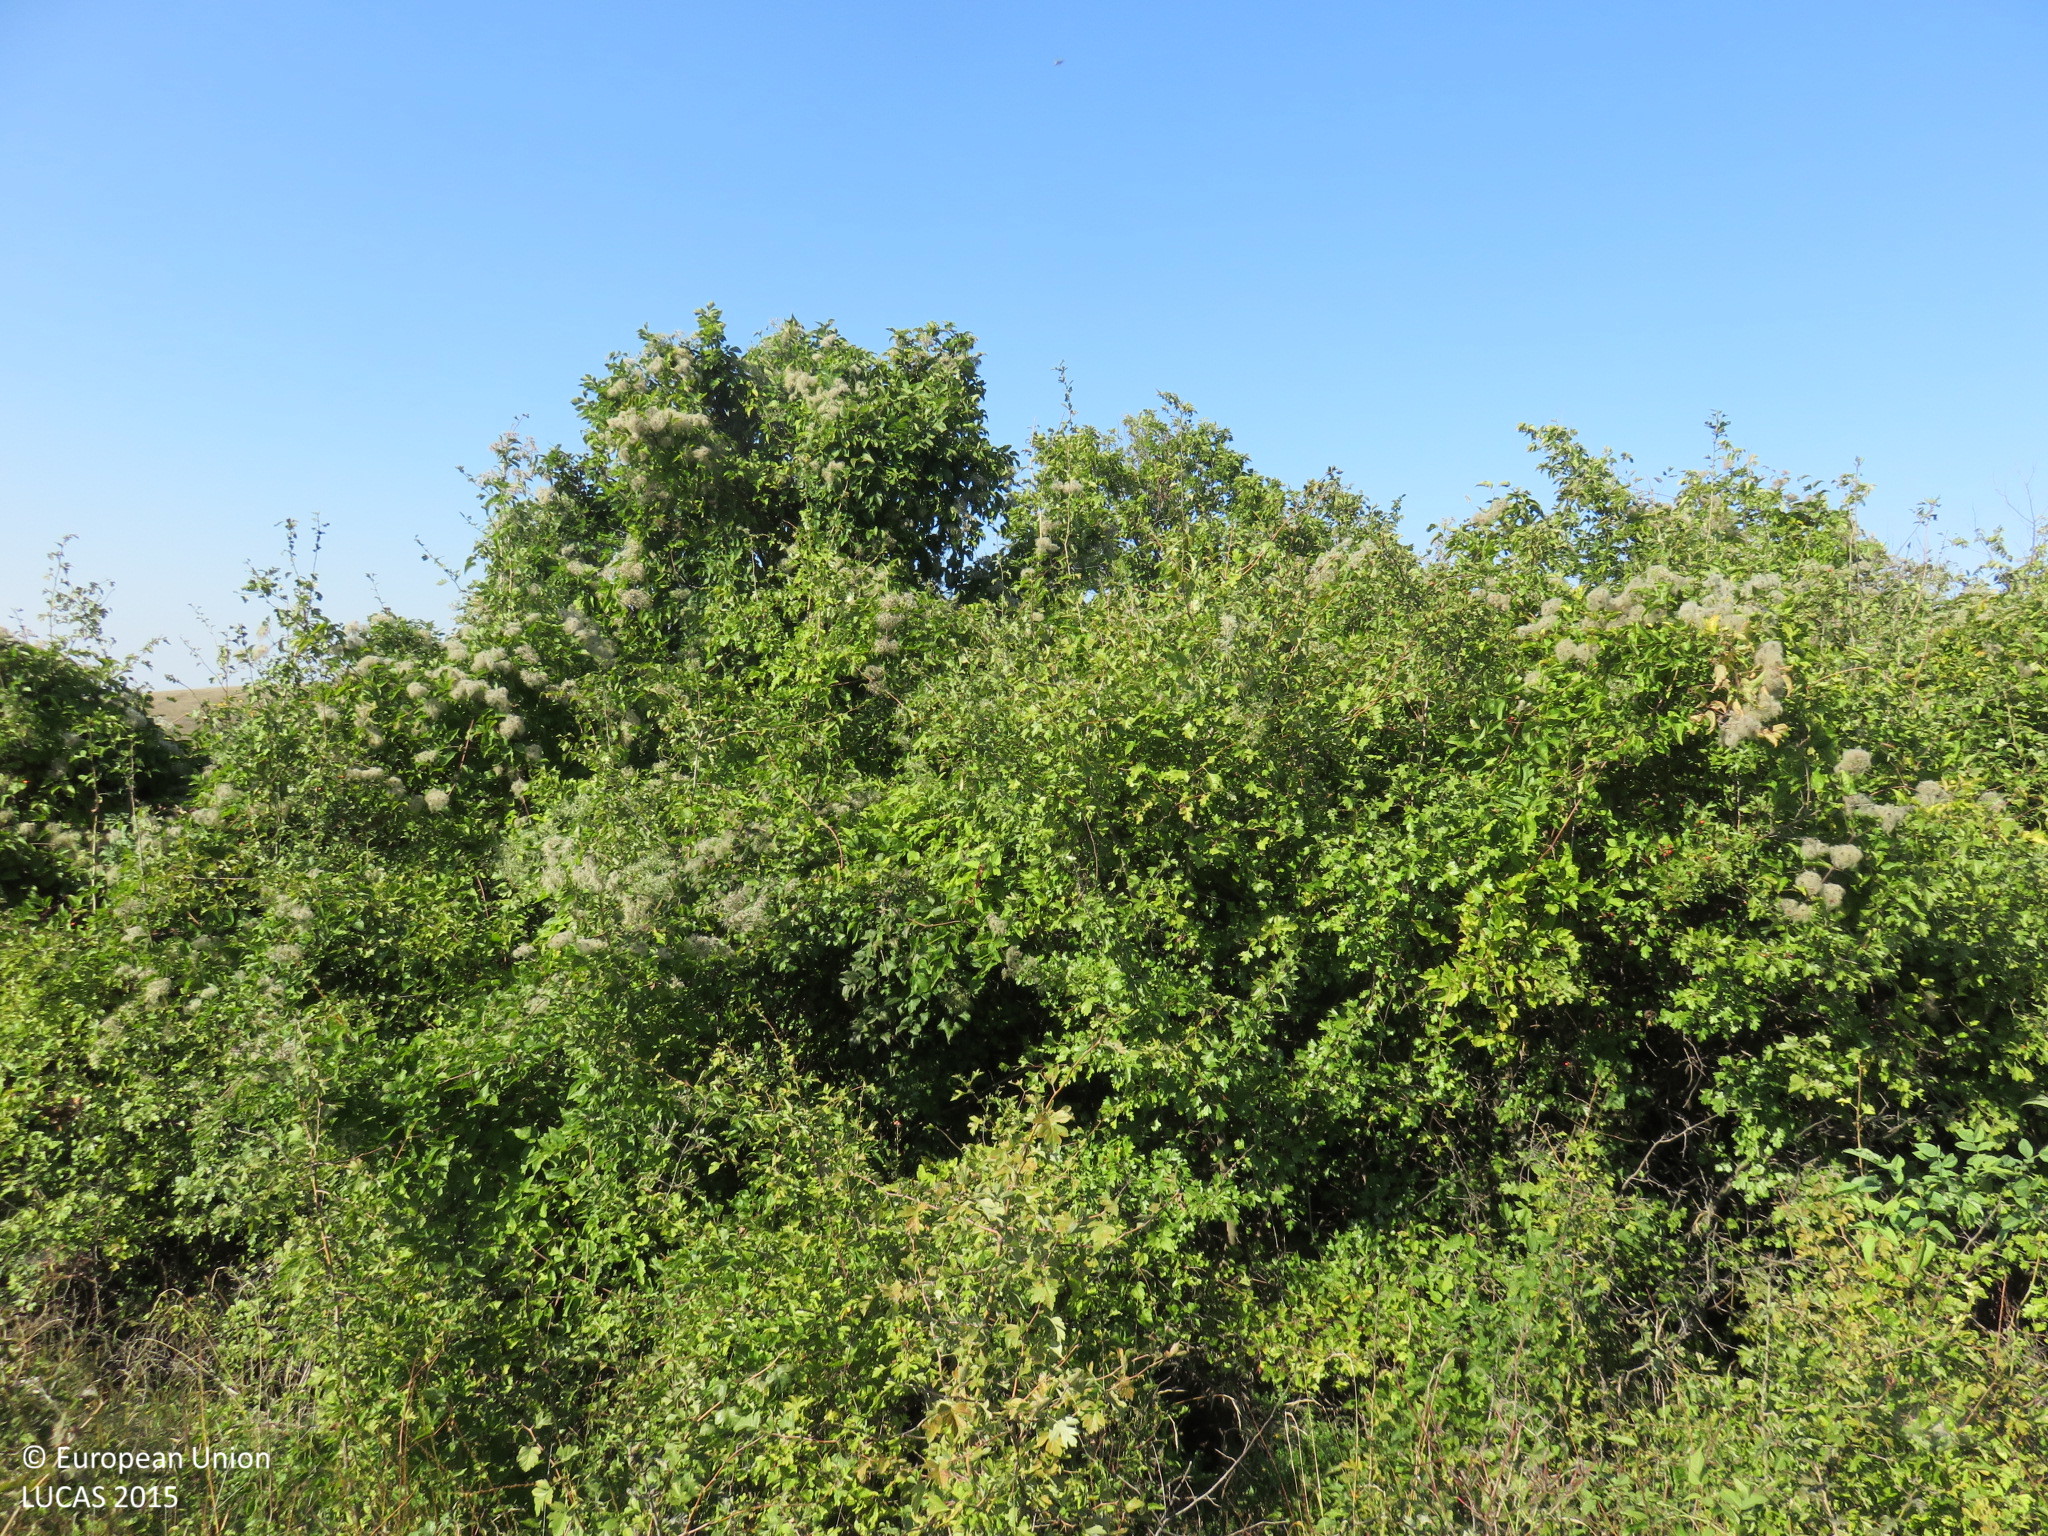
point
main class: Woodland
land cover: Broadleaved woodland
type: mesophytic deciduous forest
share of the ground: 50 - 75 %
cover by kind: broadleaved forest trees 70 %, shrubs 30 %
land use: Semi-natural and natural areas not in use
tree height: < 5 m
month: September
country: BG
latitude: 43.6610
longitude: 24.4594
